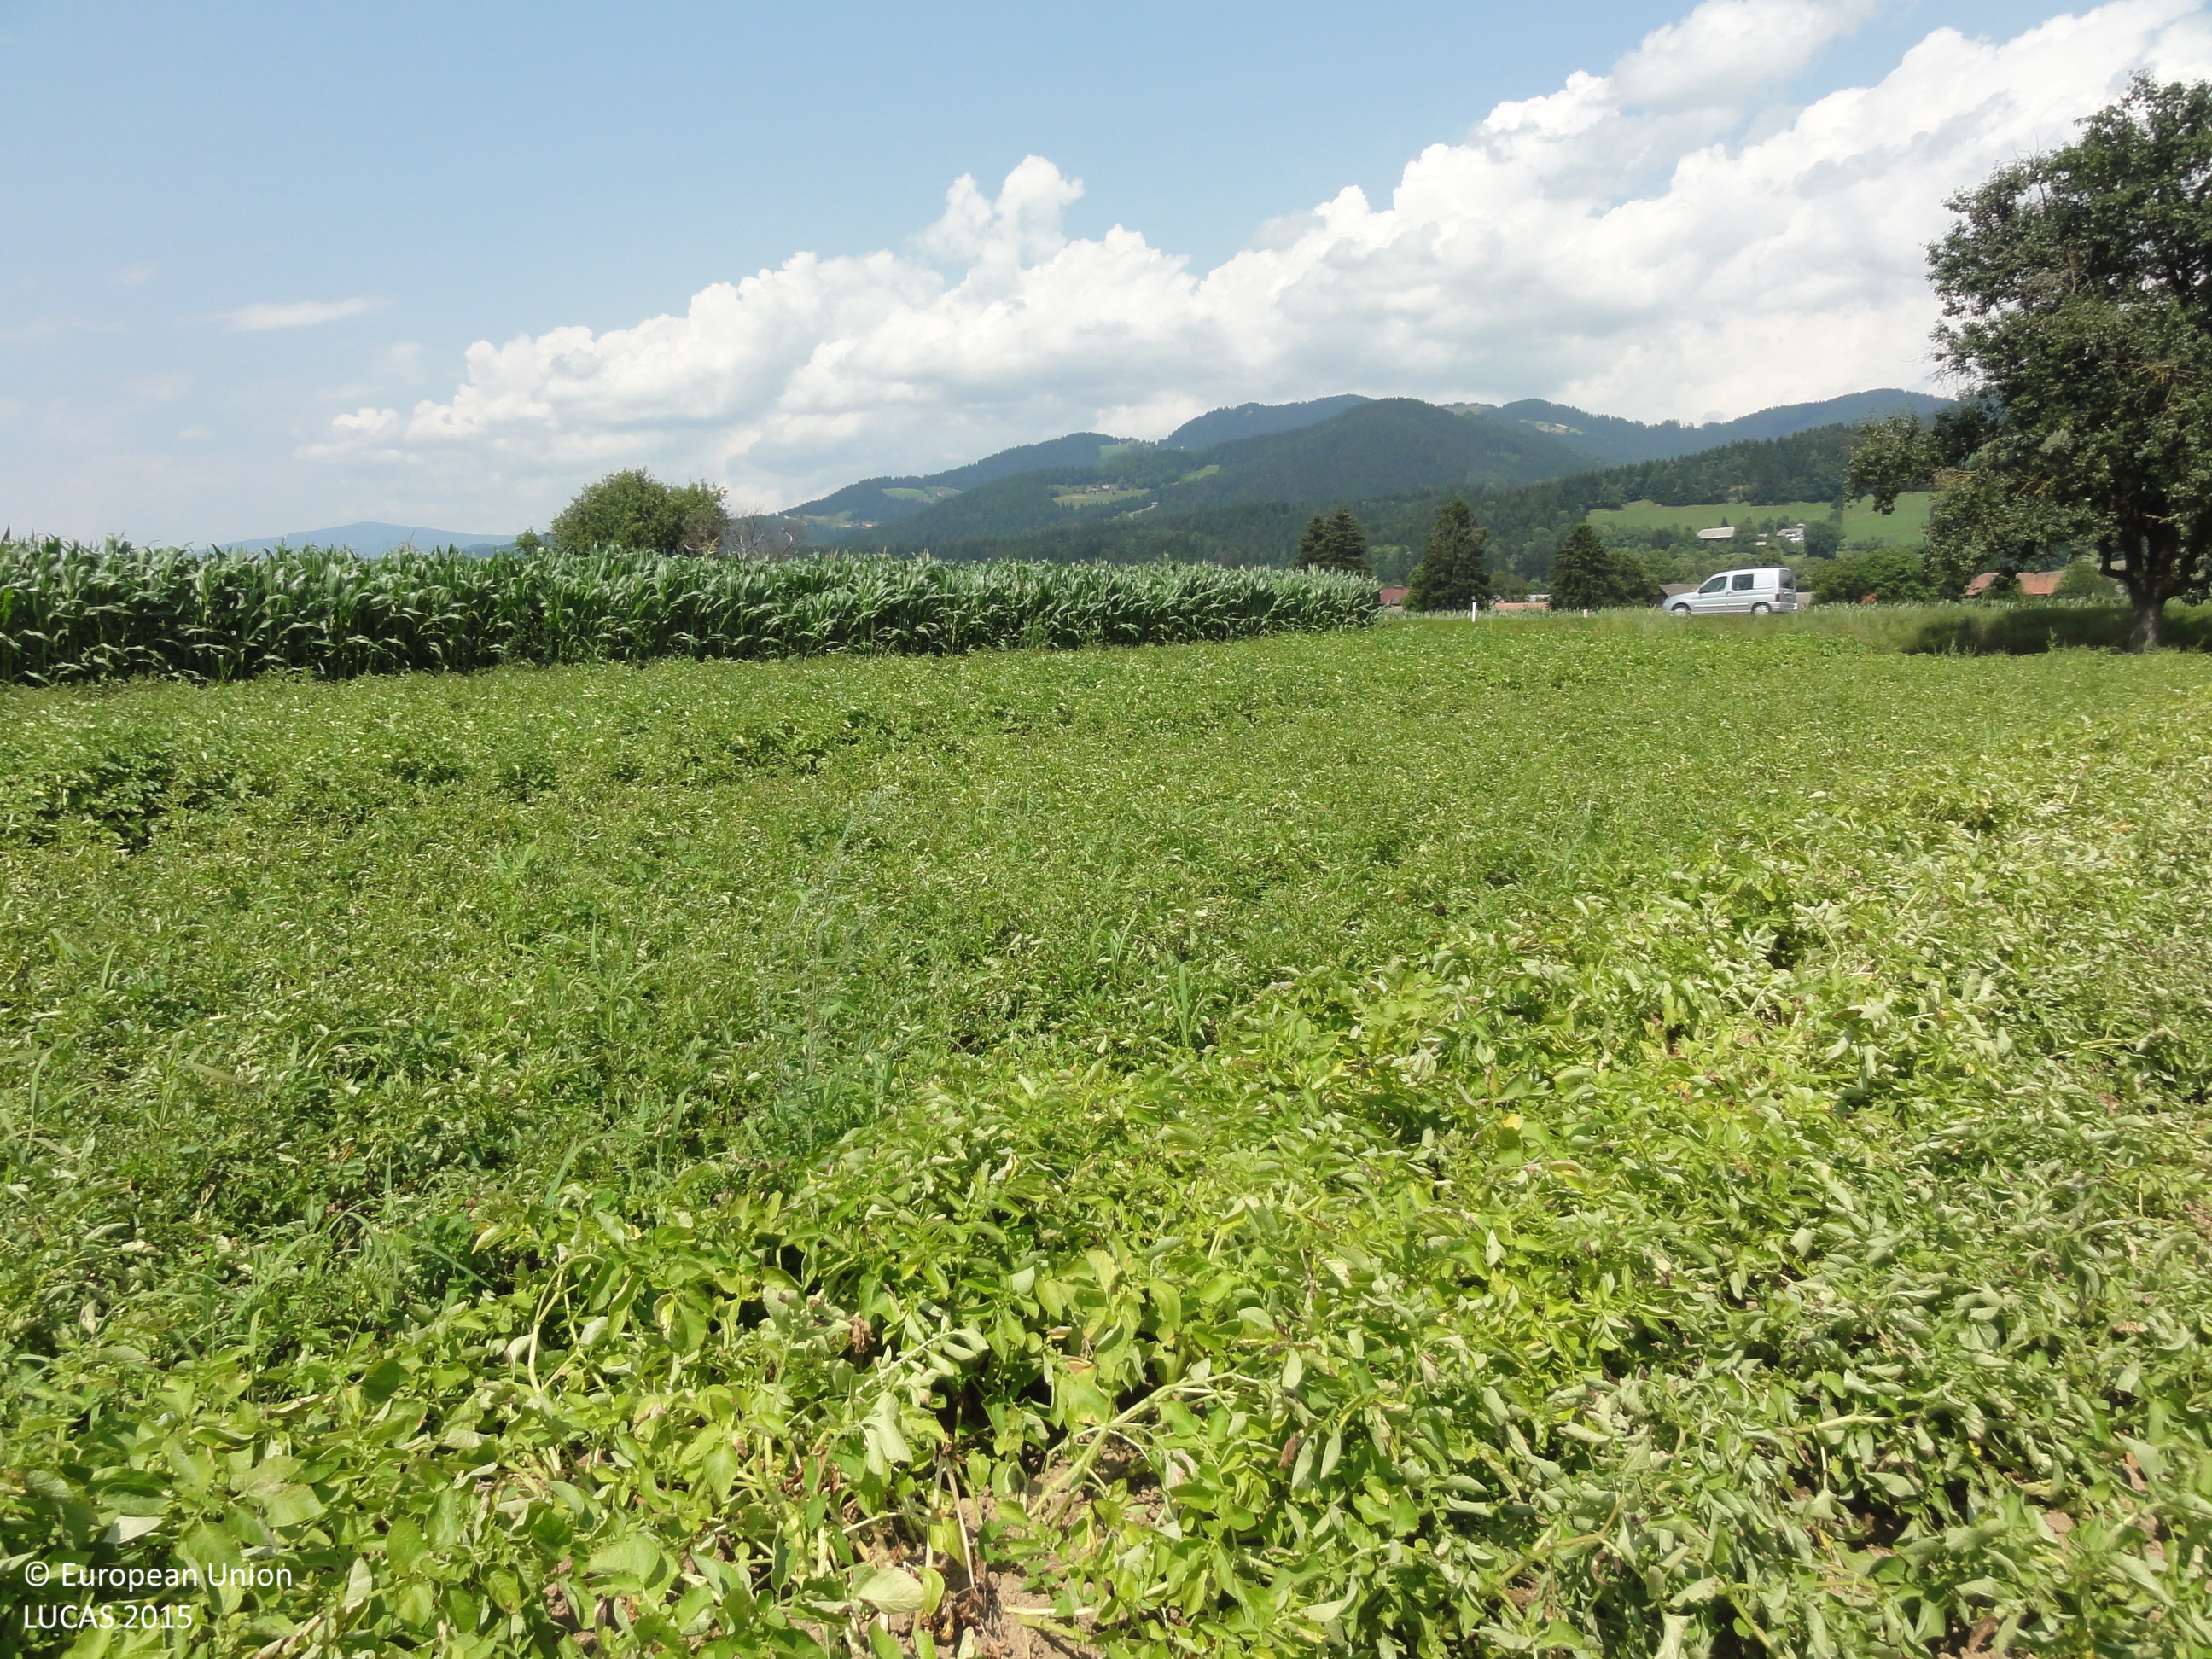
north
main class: Cropland
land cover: Common wheat
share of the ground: > 75 %
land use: Agriculture (excluding fallow land and kitchen gardens)
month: July
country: SI
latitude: 46.4814
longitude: 15.1172
